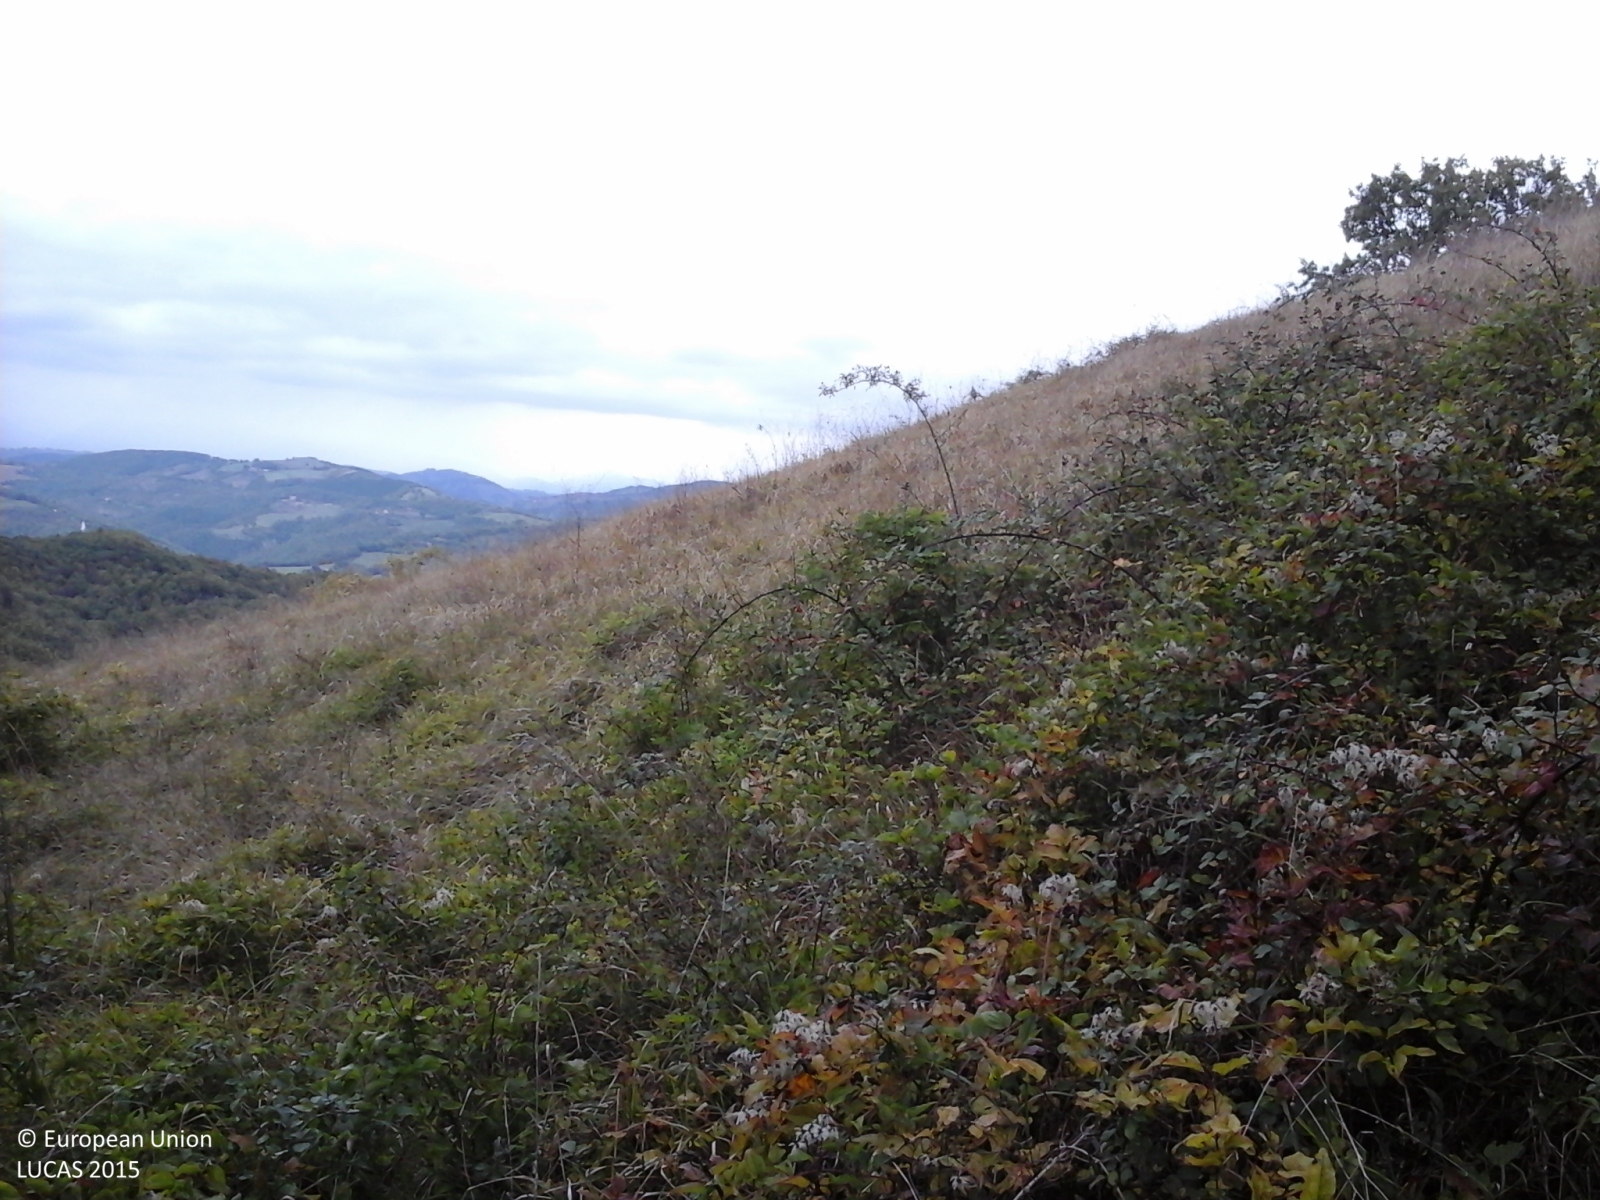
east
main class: Woodland
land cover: Broadleaved woodland
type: thermophilous deciduous forest
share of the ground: > 75 %
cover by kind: broadleaved forest trees 90 %, shrubs 10 %
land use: Forestry
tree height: > 5 m
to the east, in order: Broadleaved woodland; Shrubland without tree cover; Grassland with sparse tree/shrub cover; Fences; Broadleaved woodland
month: October
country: IT
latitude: 43.1996
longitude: 12.5649
